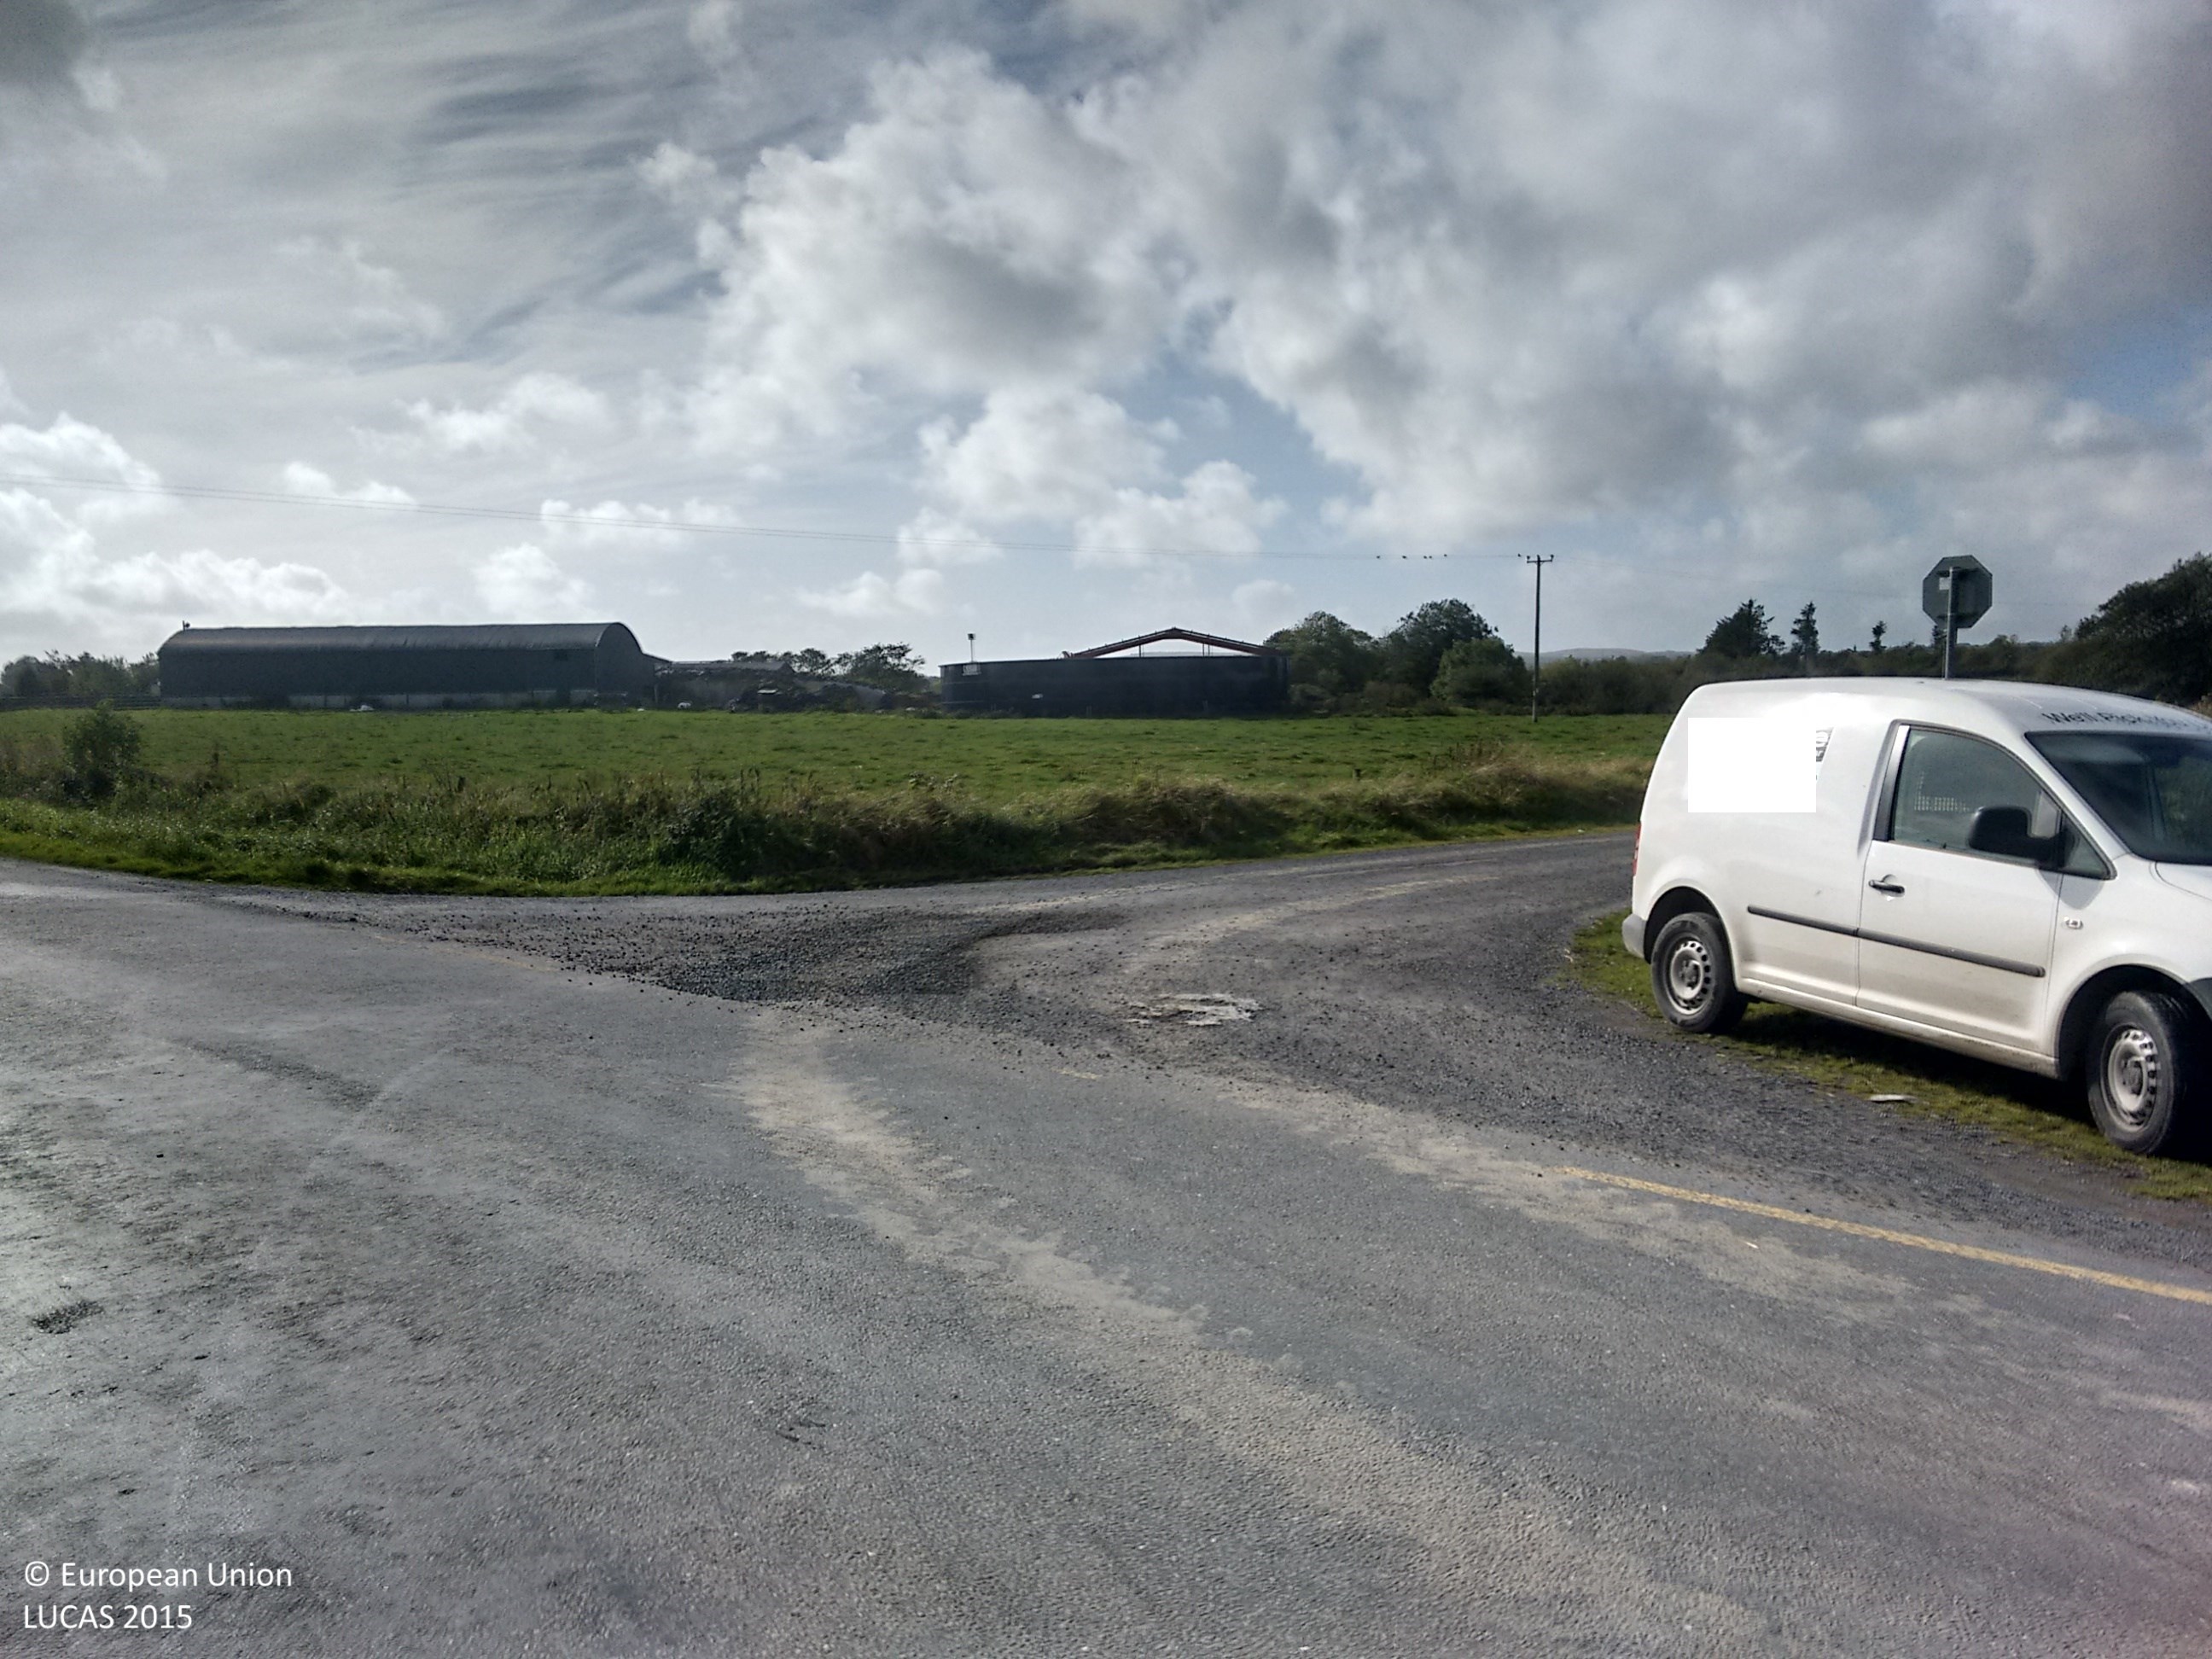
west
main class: Grassland
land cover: Grassland without tree/shrub cover
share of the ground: > 75 %
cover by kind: herbaceous plants 100 %
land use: Agriculture (excluding fallow land and kitchen gardens)
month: September
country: IE
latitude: 52.5167
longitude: -9.4933
